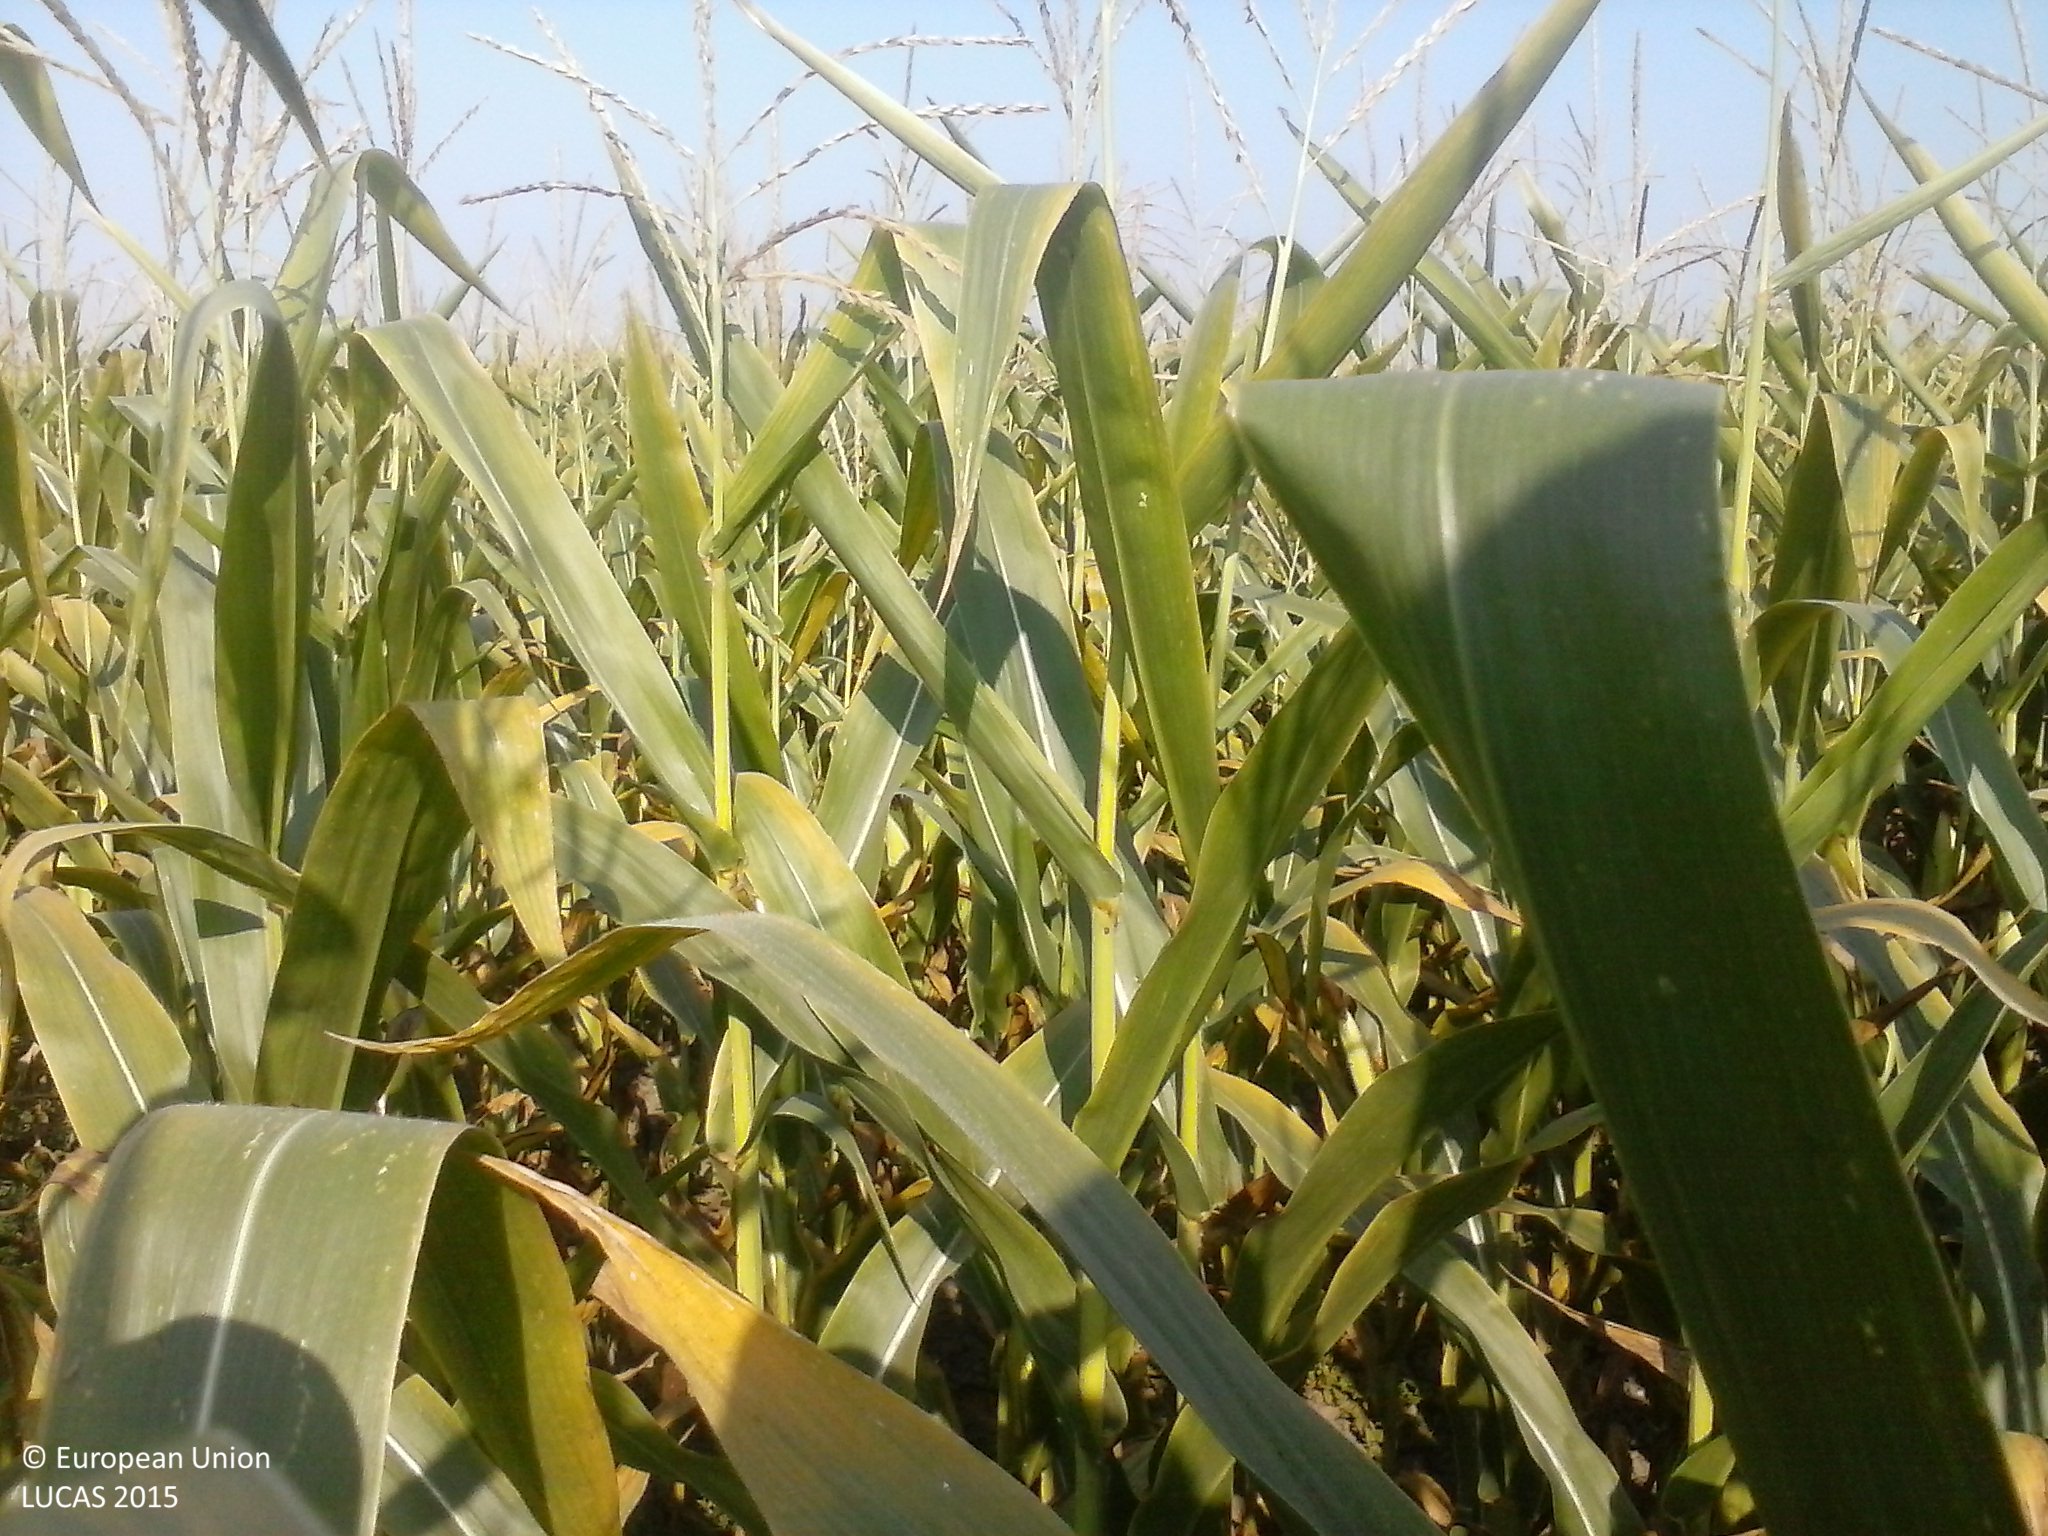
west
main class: Cropland
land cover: Maize
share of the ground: > 75 %
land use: Agriculture (excluding fallow land and kitchen gardens)
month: August
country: HU
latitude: 45.8955
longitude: 17.9052
